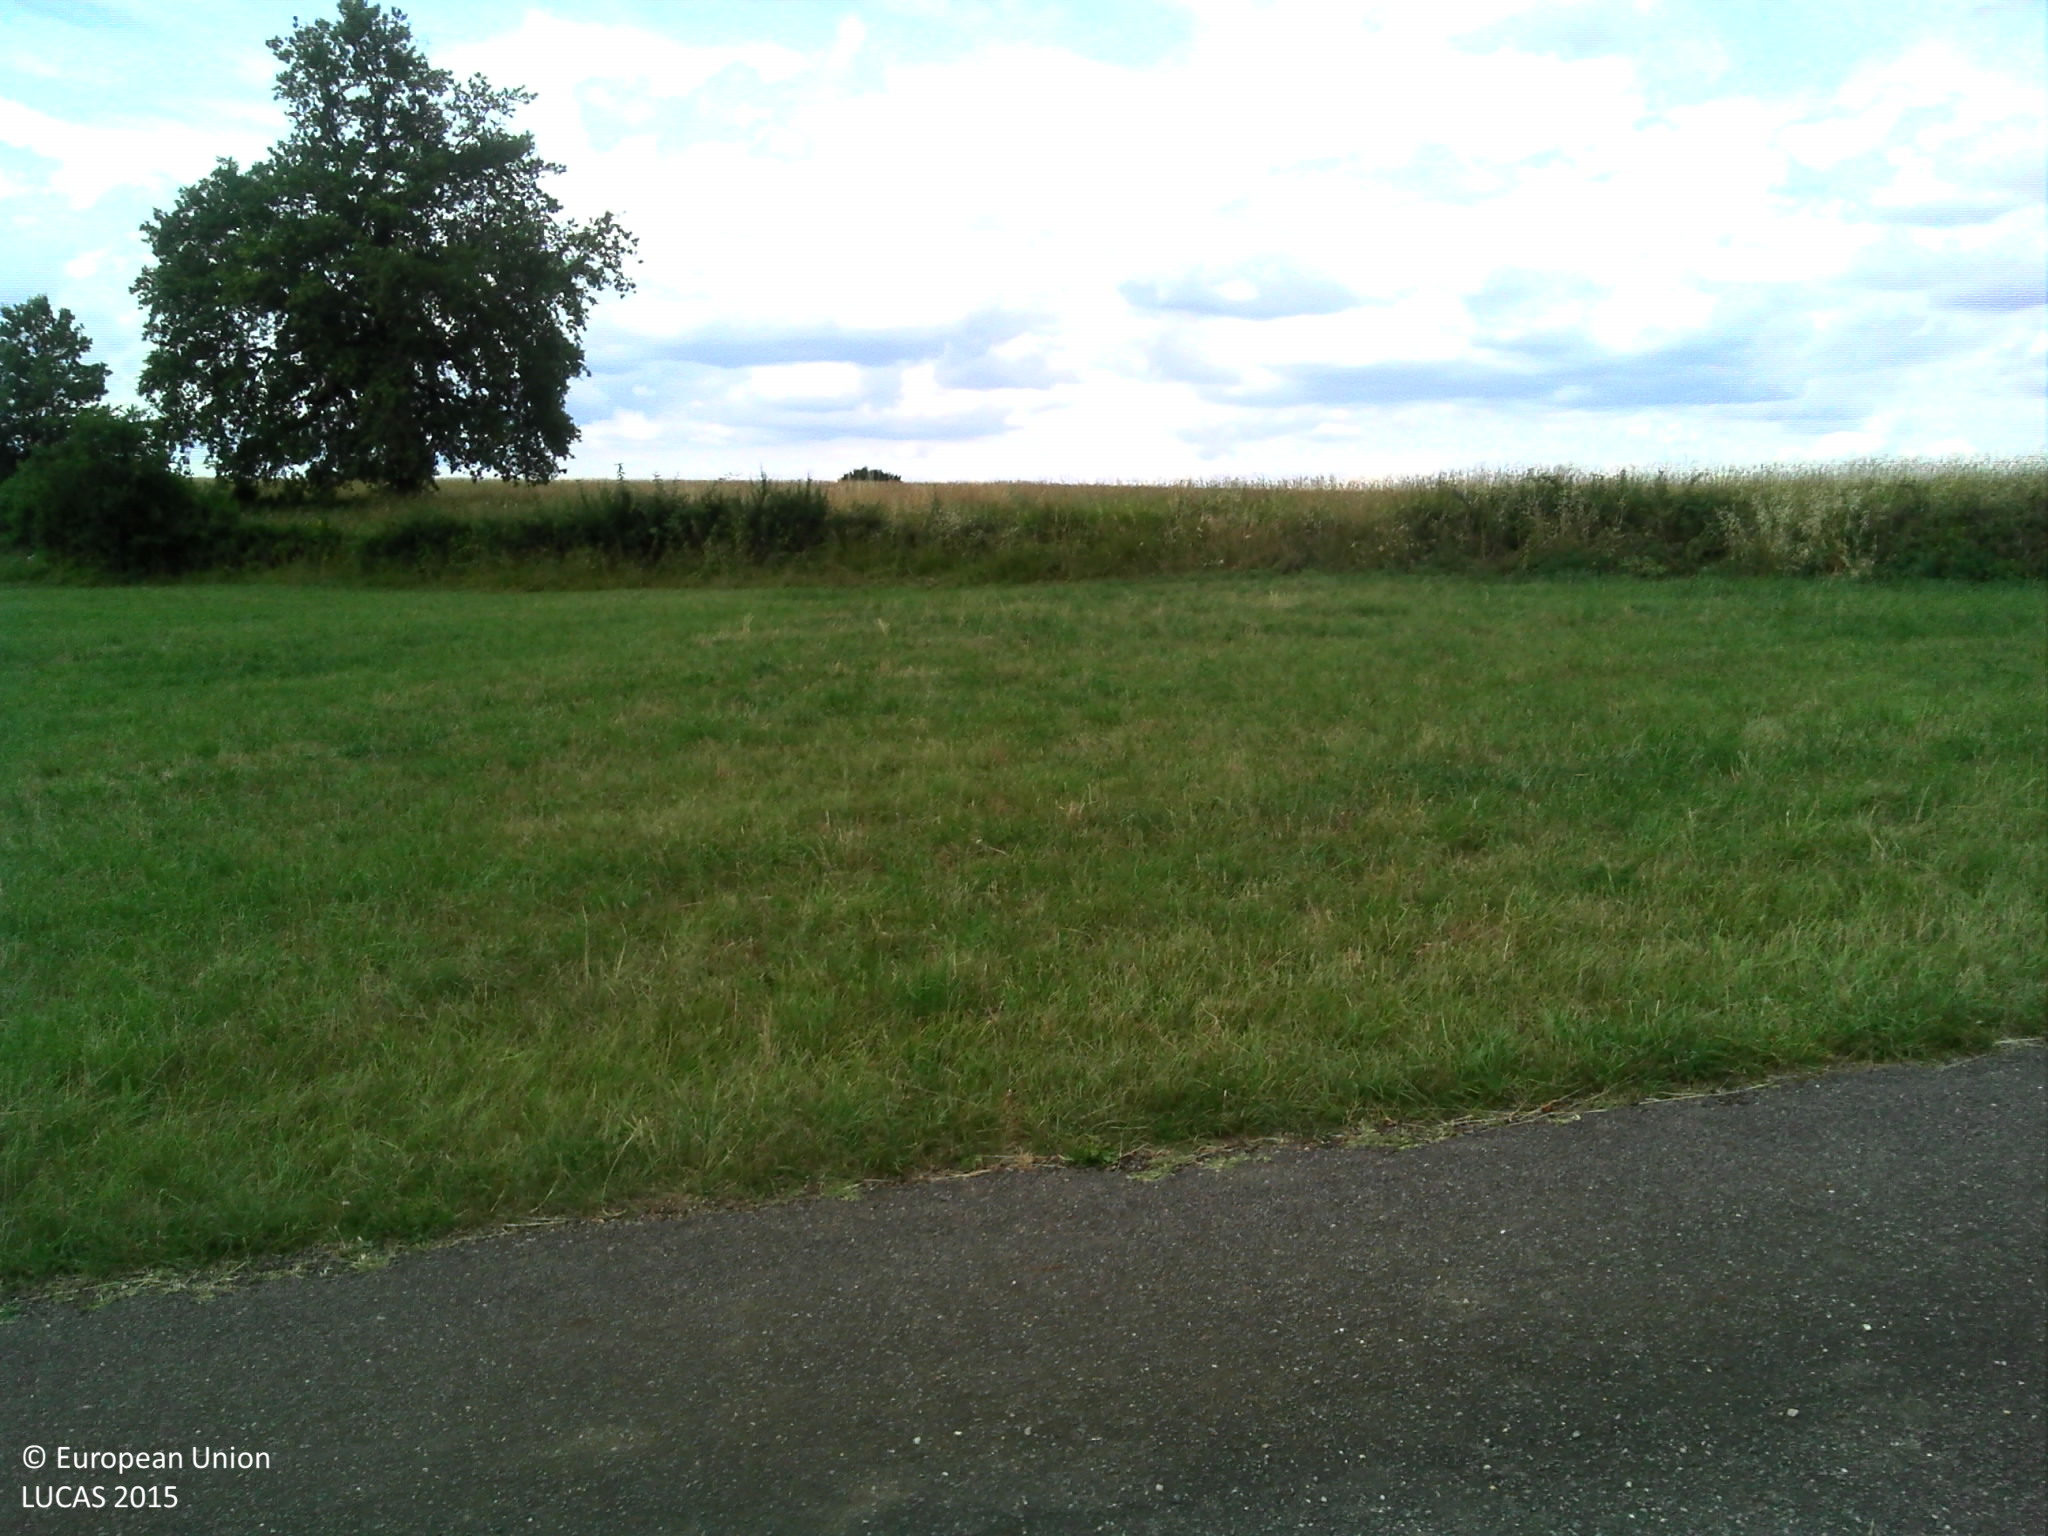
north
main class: Cropland
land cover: Barley
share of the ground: 50 - 75 %
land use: Agriculture (excluding fallow land and kitchen gardens)
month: June
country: FR
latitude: 44.1254
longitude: 1.9163
